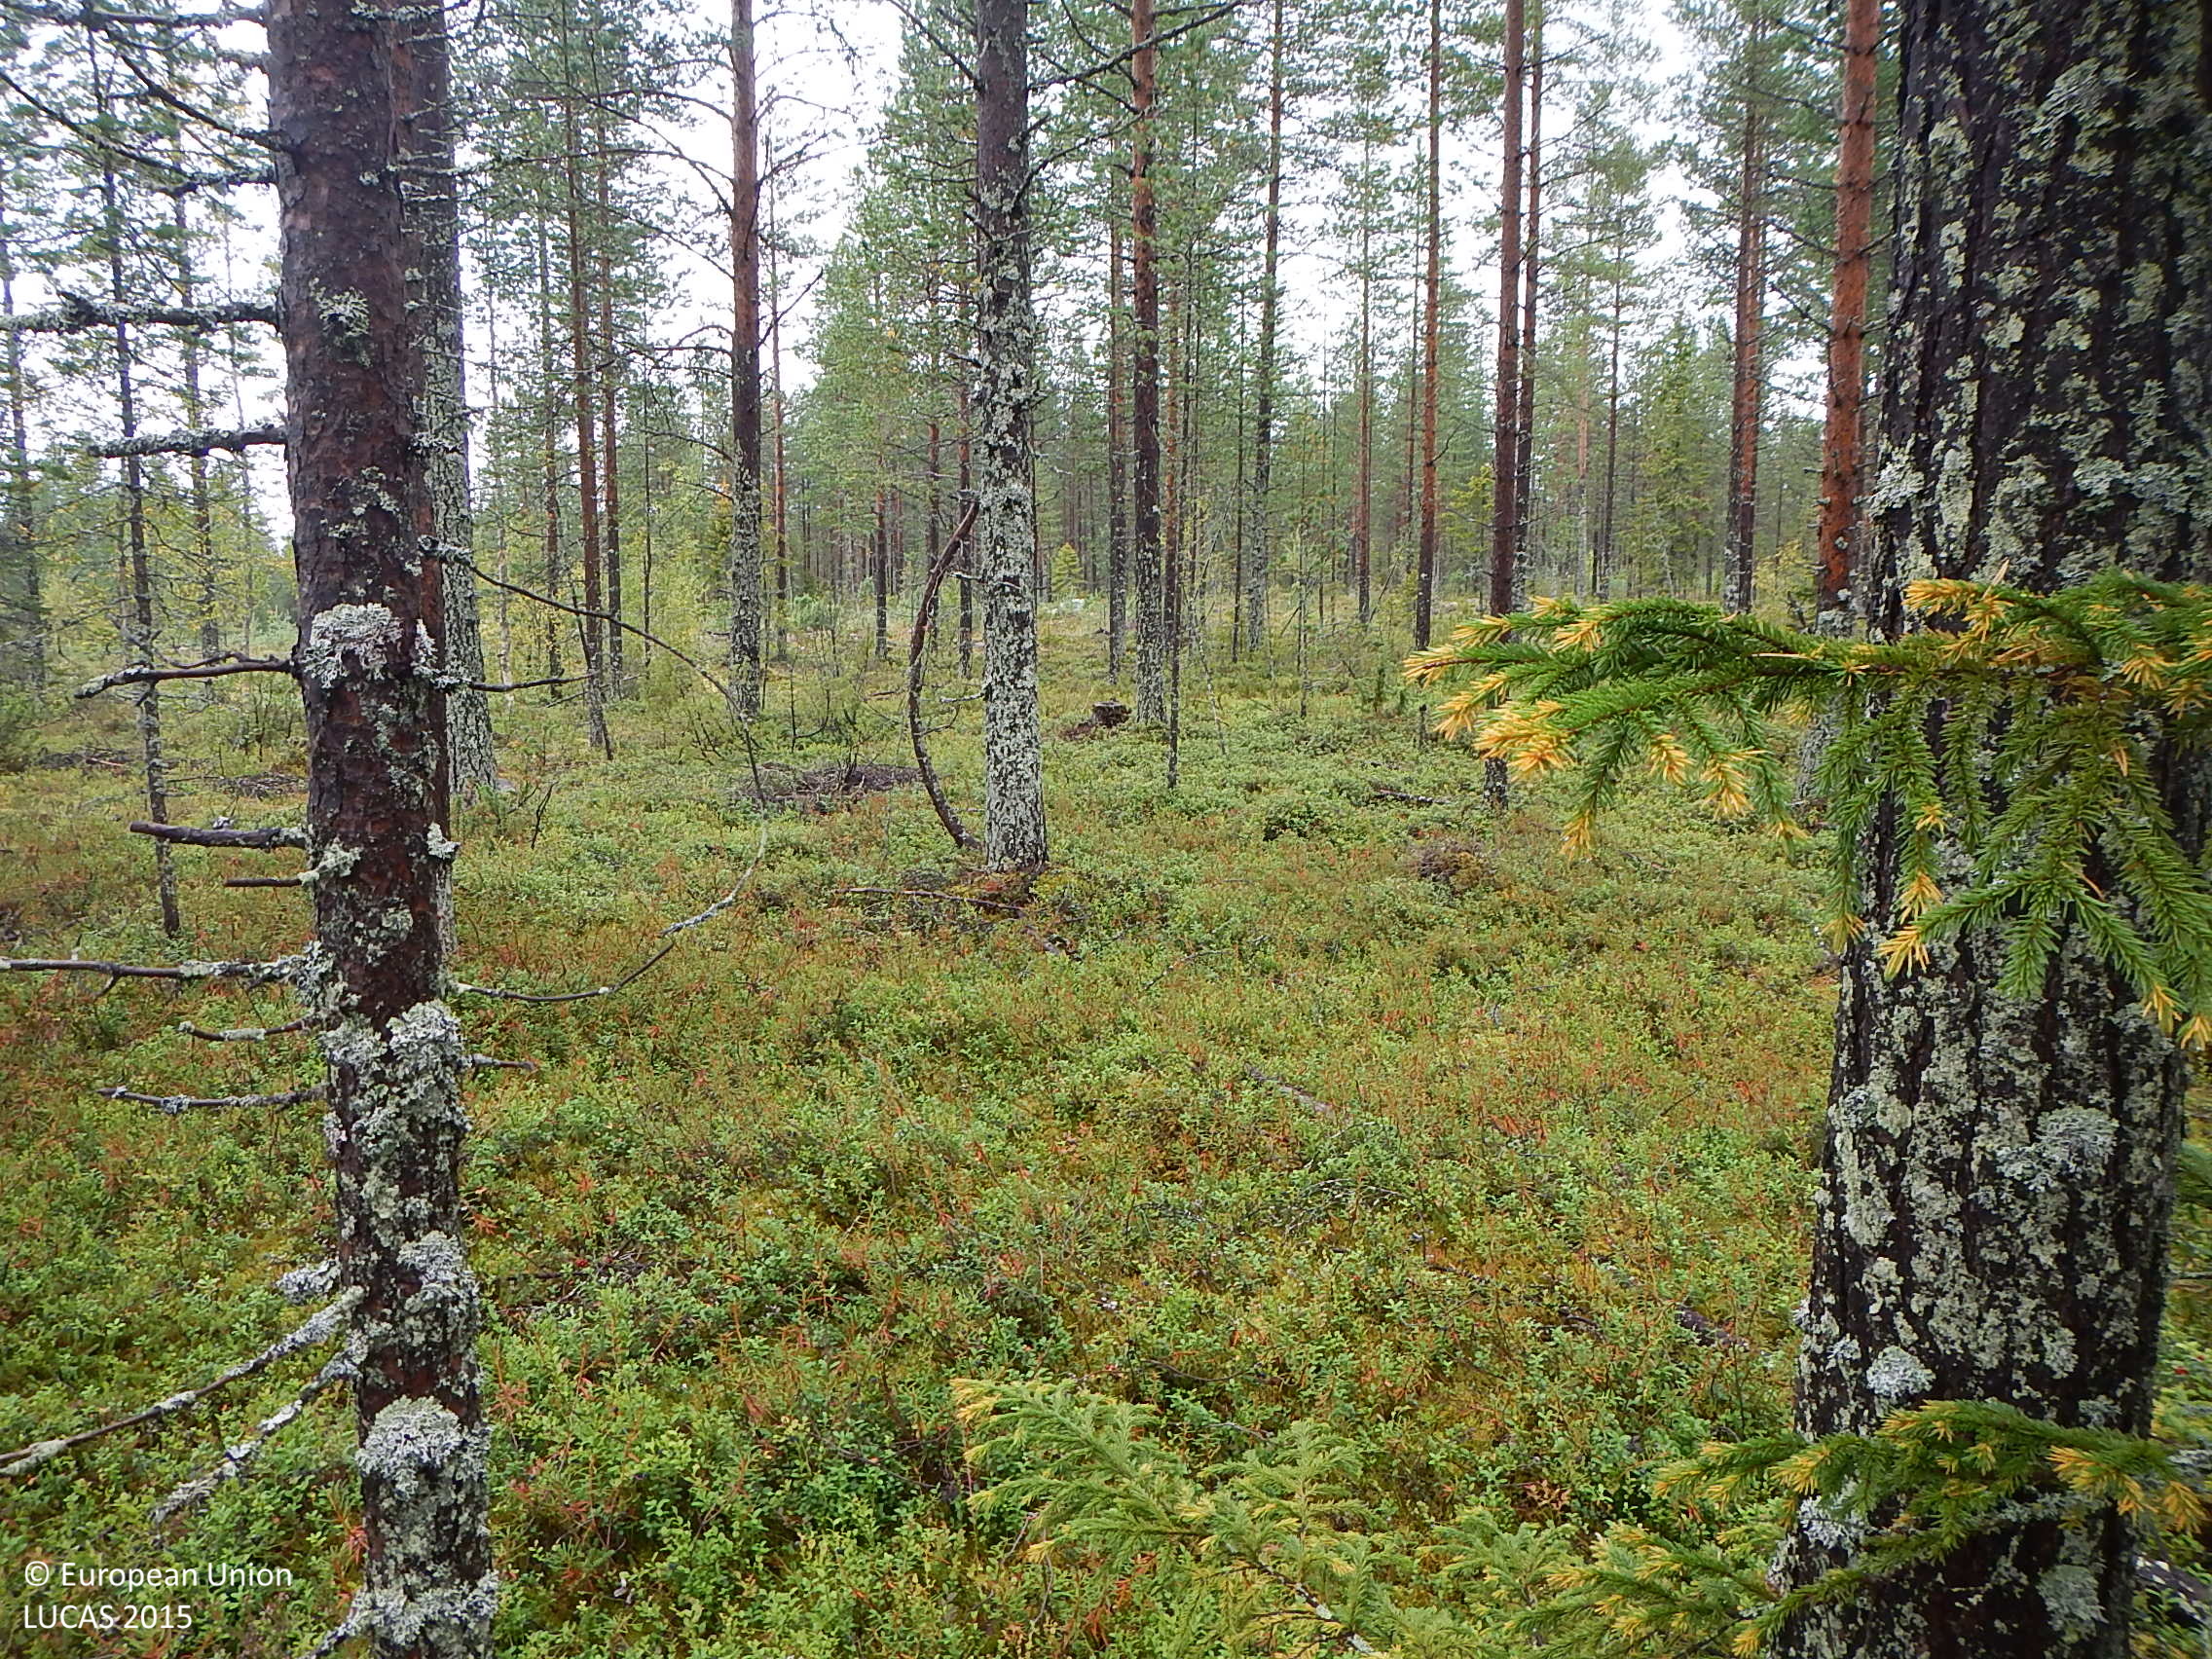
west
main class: Woodland
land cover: Pine dominated coniferous woodland
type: boreal forest
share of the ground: 50 - 75 %
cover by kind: coniferous forest trees 70 %, shrubs 25 %, lichens and mosses 5 %
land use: Forestry
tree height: > 5 m
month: August
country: FI
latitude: 65.7764
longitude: 26.9948
